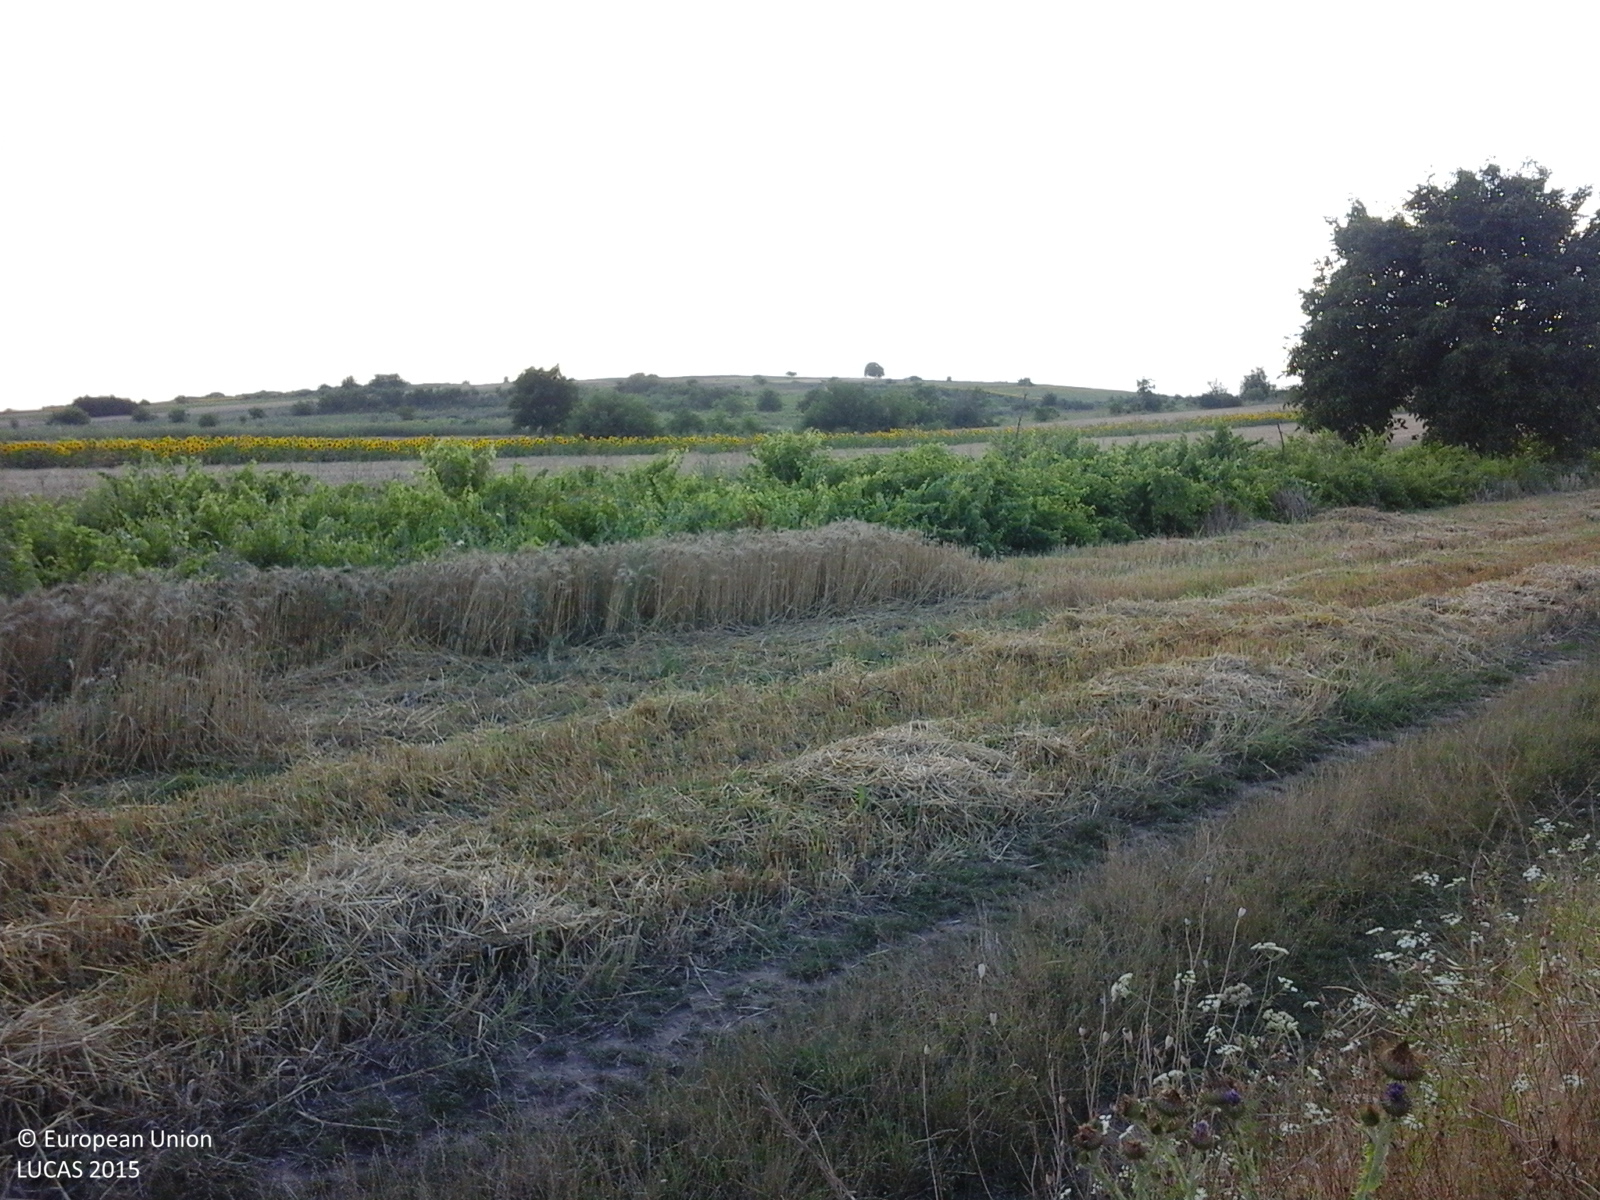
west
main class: Cropland
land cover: Rape and turnip rape
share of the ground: < 10 %
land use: Agriculture (excluding fallow land and kitchen gardens)
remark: Harvested field
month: July
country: RO
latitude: 43.9128
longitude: 25.8463
